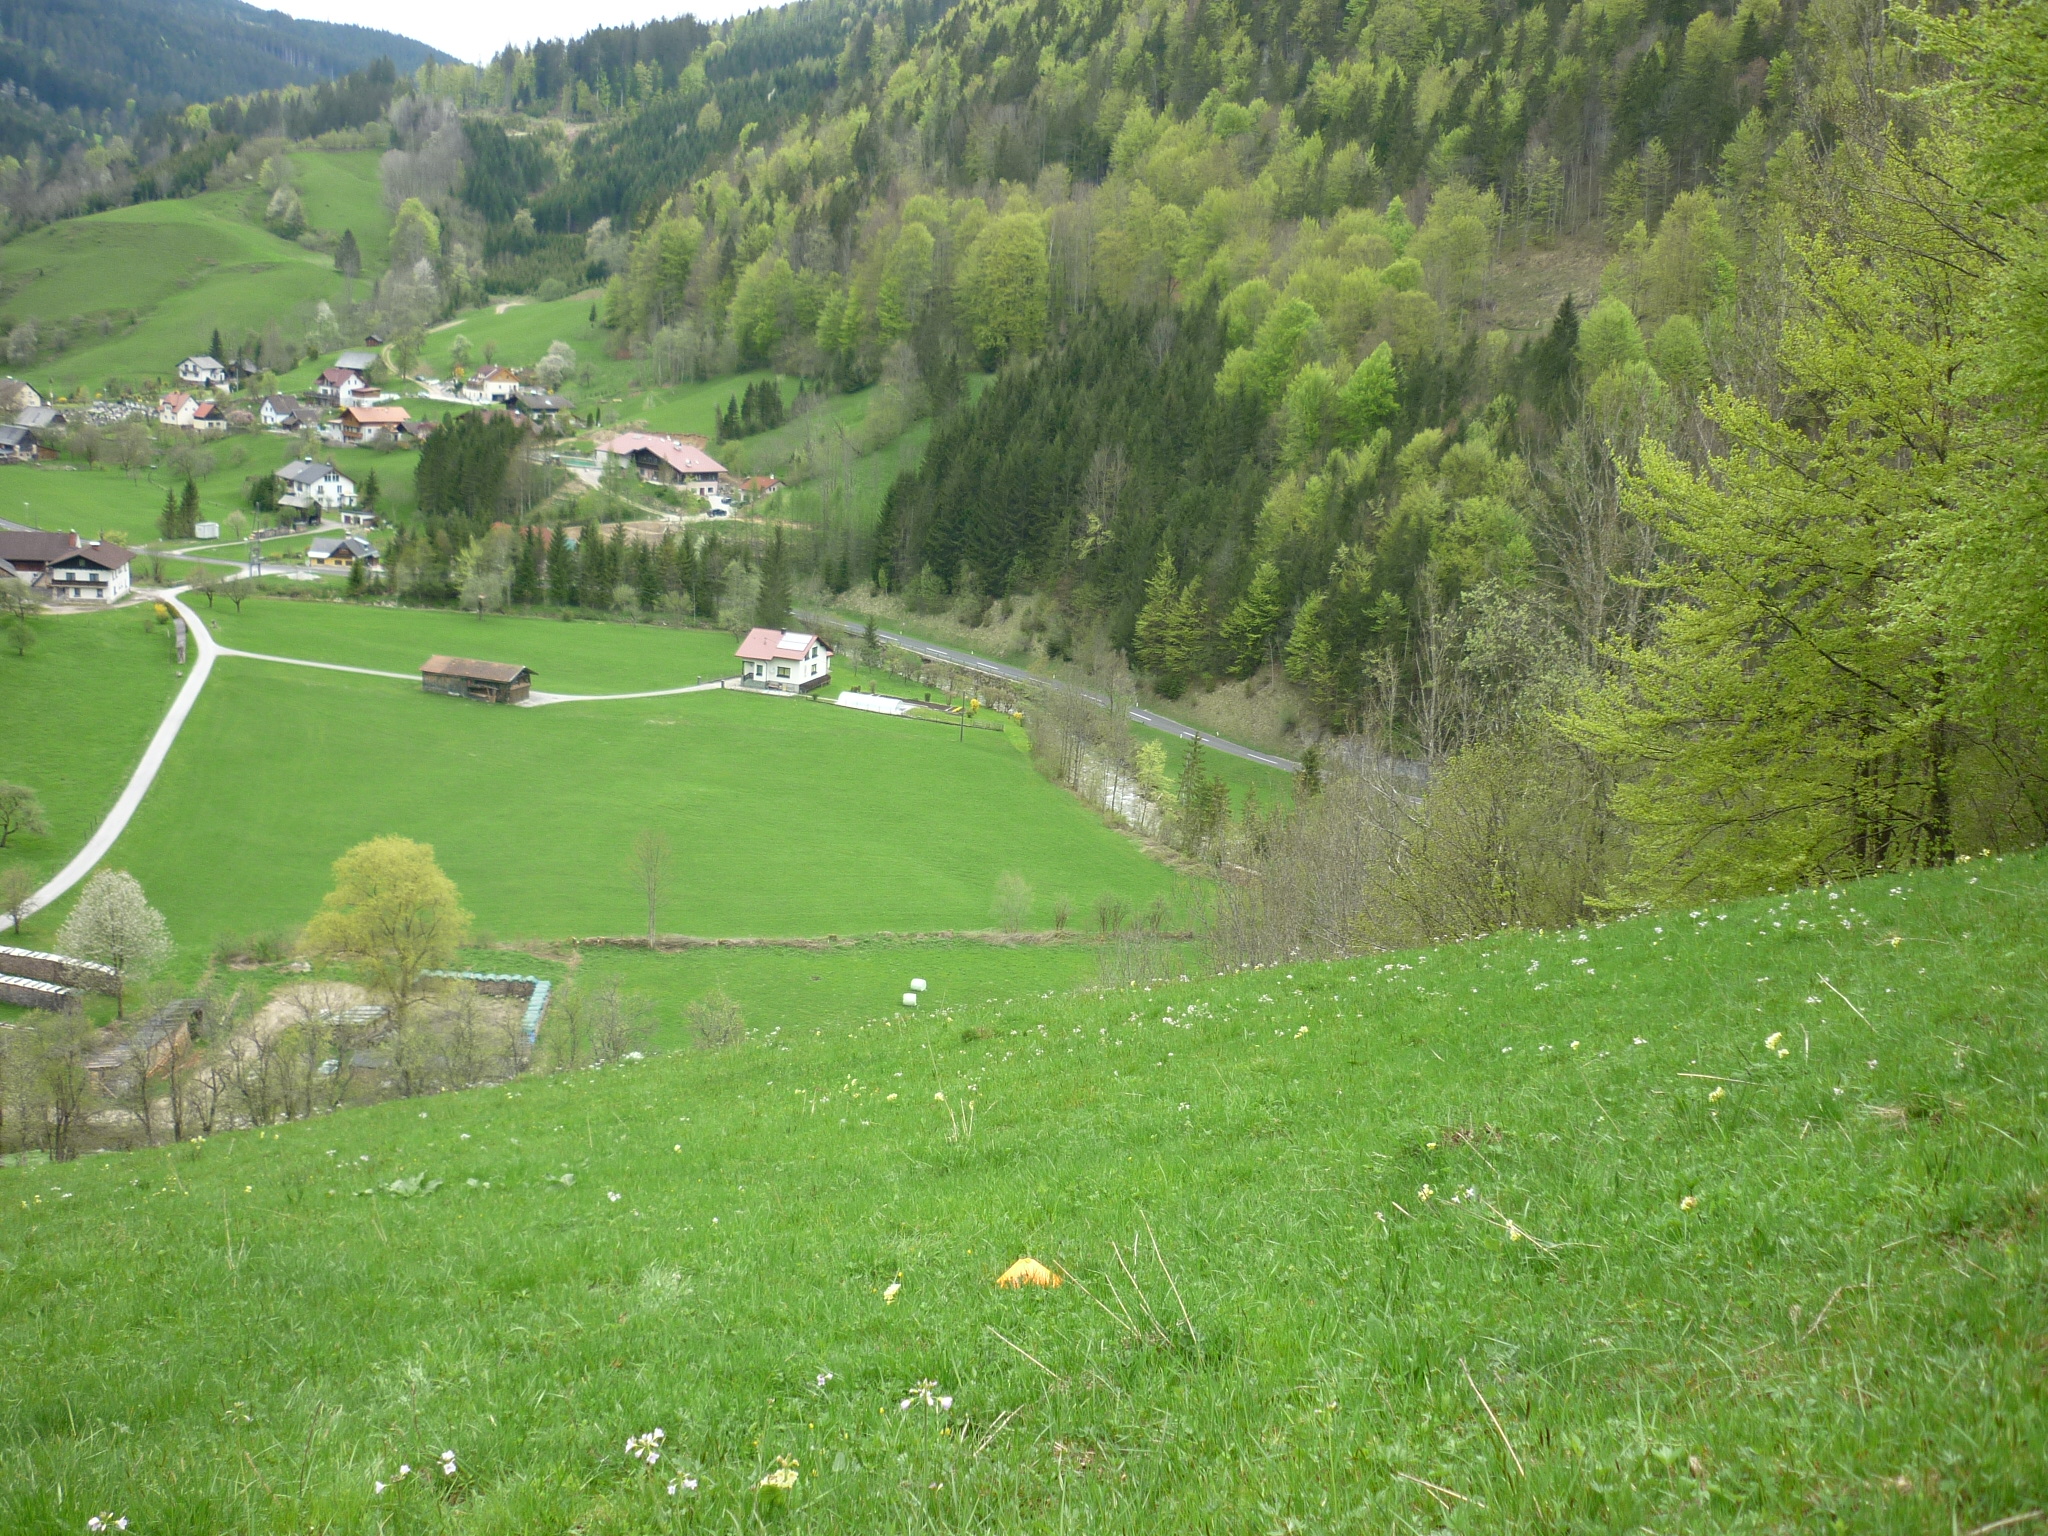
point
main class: Grassland
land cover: Grassland without tree/shrub cover
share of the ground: > 75 %
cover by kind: herbaceous plants 90 %, lichens and mosses 5 %, unconsolidated bare surface 5 %
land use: Agriculture (excluding fallow land and kitchen gardens)
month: May
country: AT
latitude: 47.7142
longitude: 14.5716
